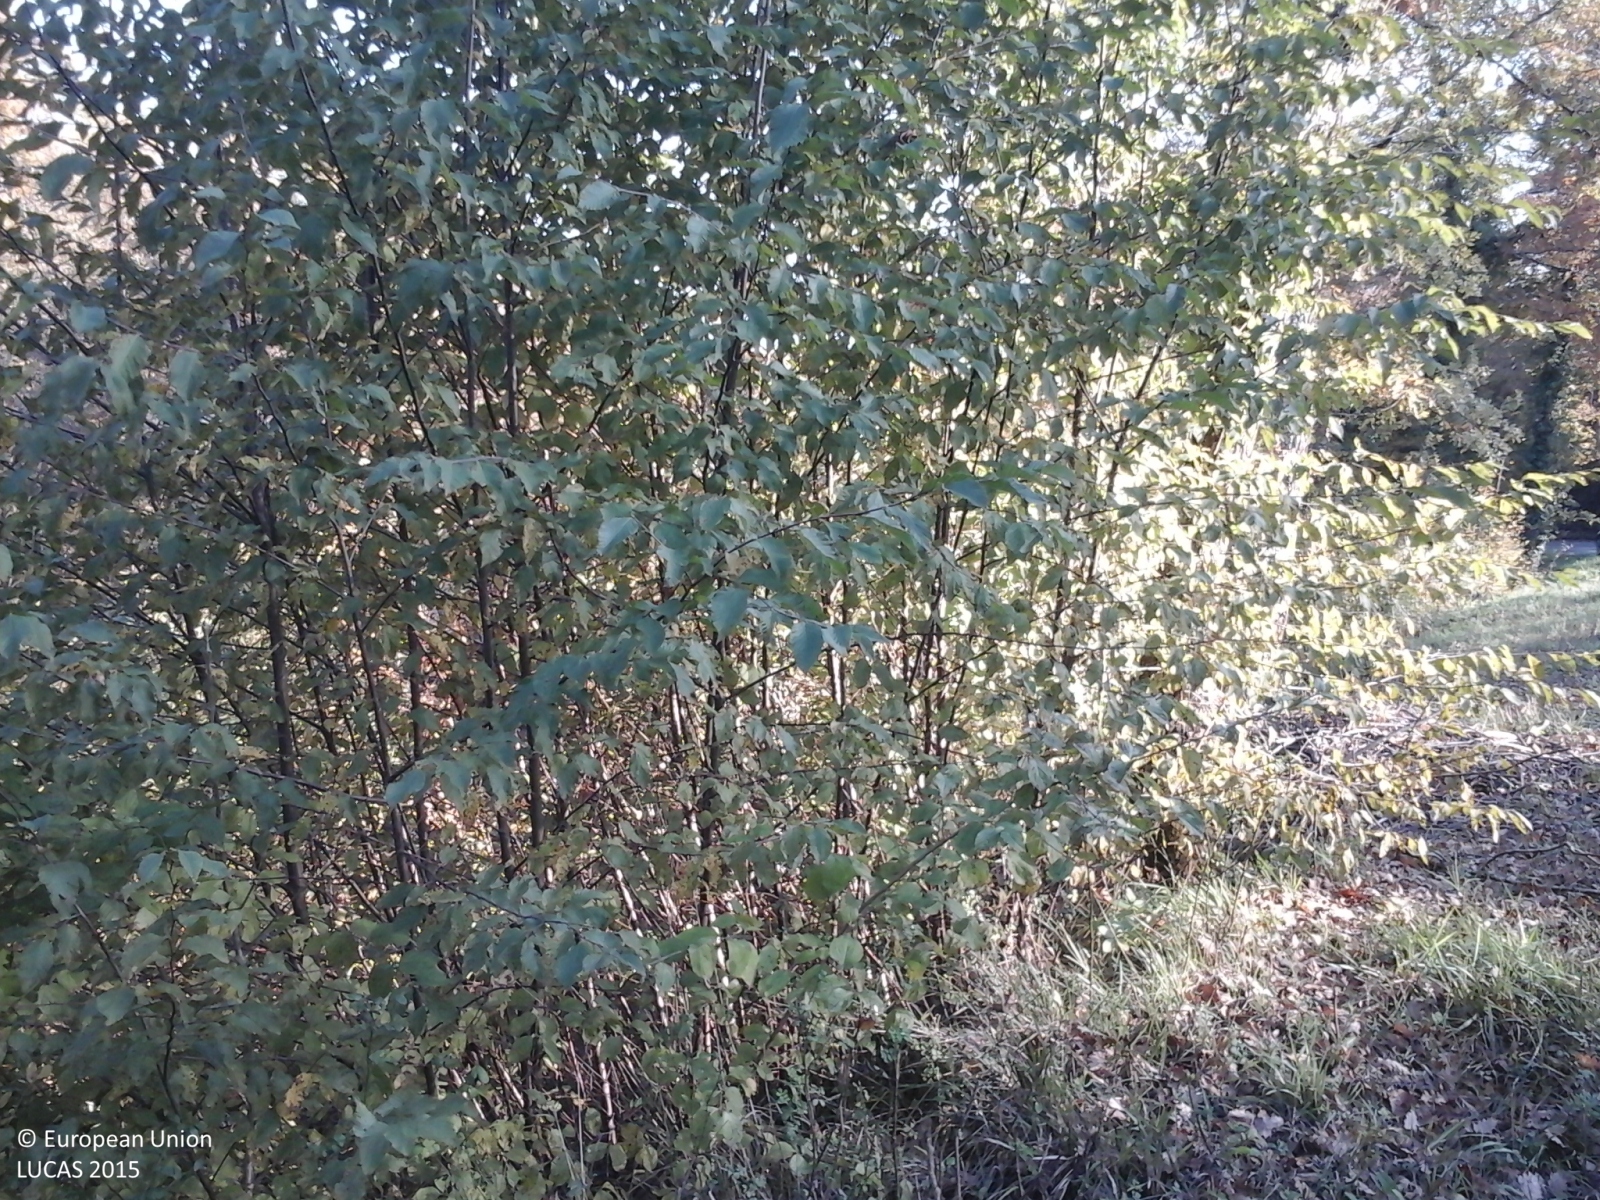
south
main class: Woodland
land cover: Broadleaved woodland
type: mesophytic deciduous forest
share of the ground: > 75 %
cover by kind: broadleaved forest trees 100 %
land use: Forestry
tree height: > 5 m
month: August
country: IT
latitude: 43.1360
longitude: 11.0663
